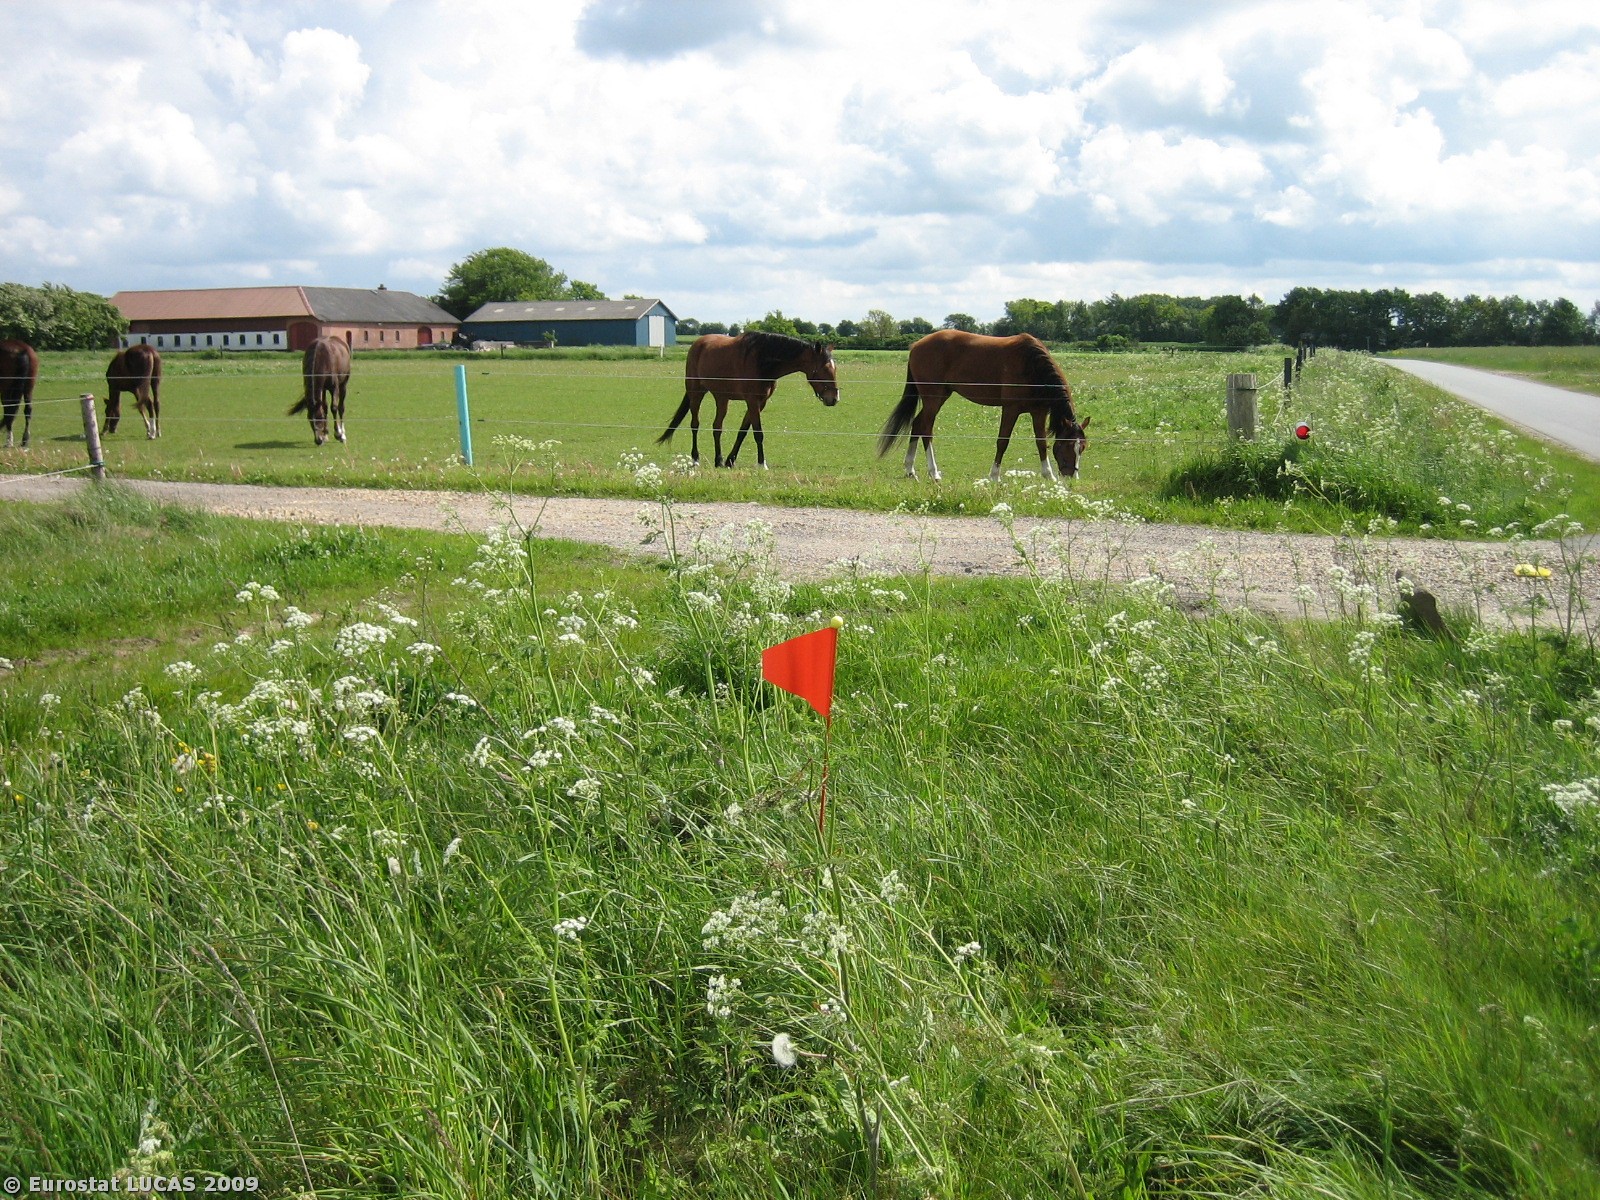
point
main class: Grassland
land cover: Grassland without tree/shrub cover
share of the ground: > 75 %
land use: Unused
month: May
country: DK
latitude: 55.9850
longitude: 8.8632
